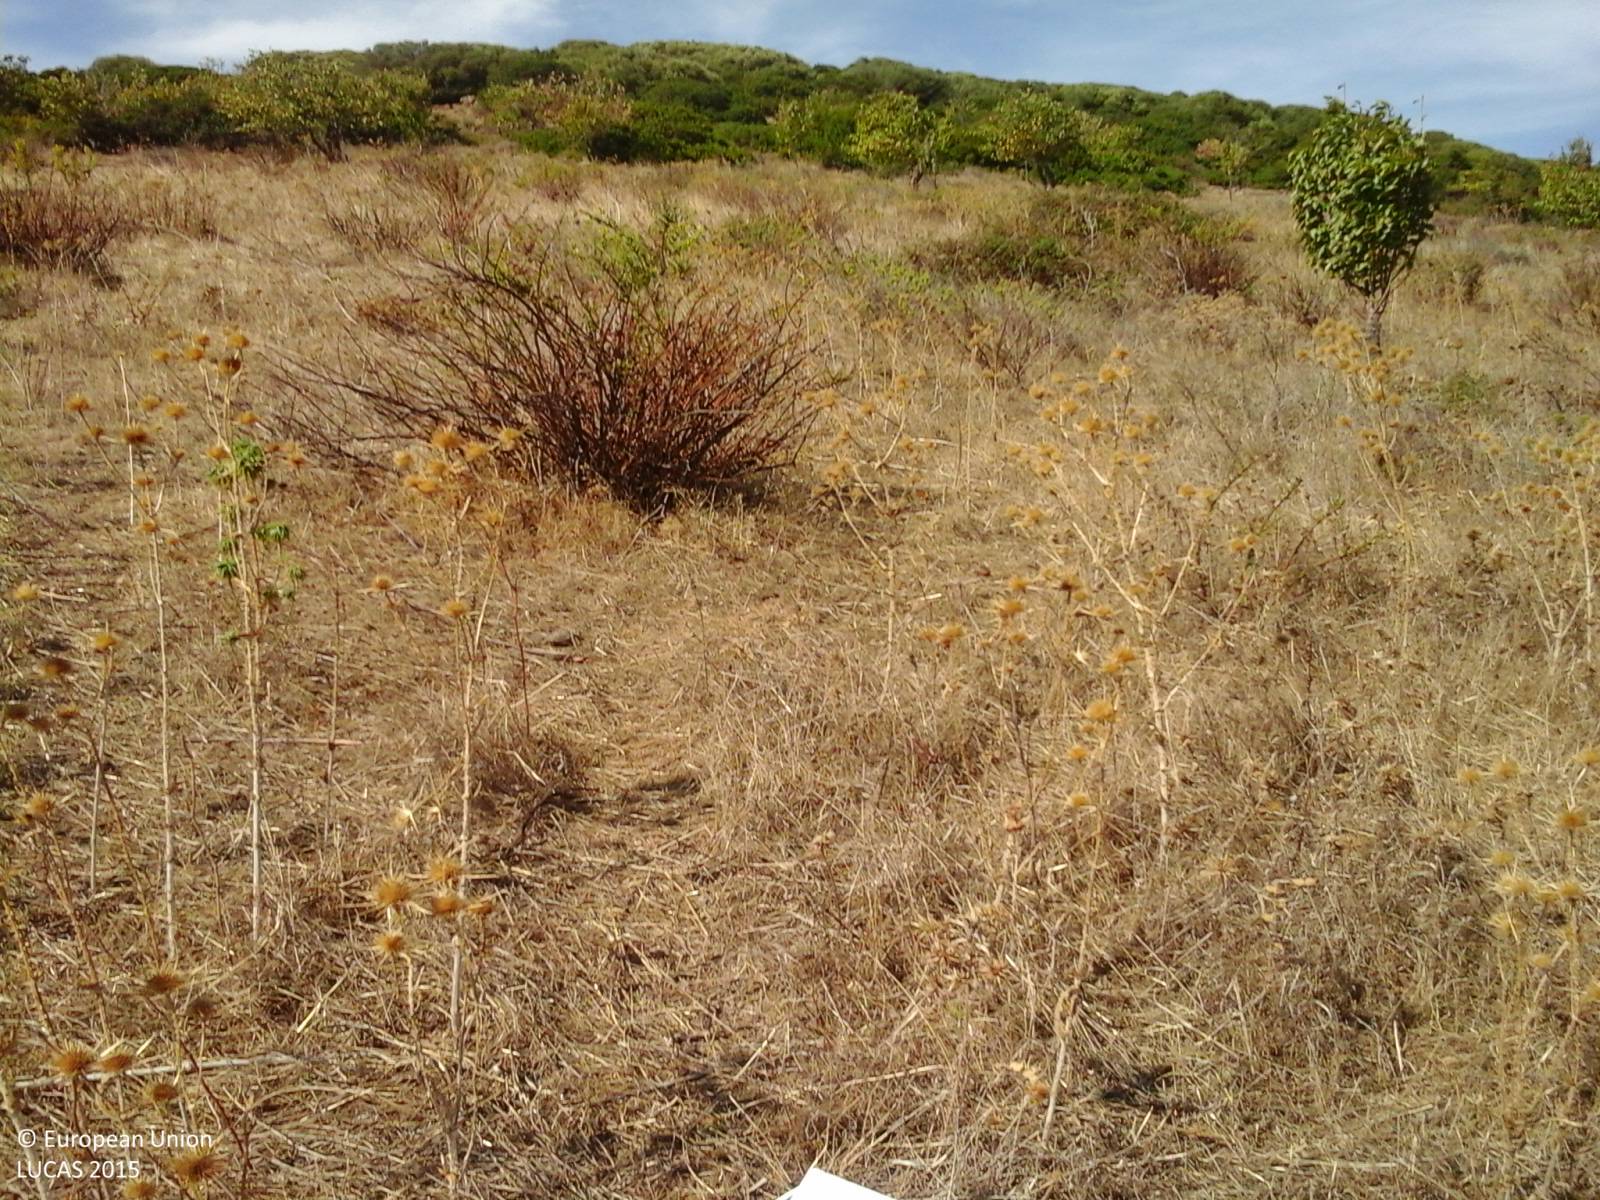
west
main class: Grassland
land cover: Grassland with sparse tree/shrub cover
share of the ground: > 75 %
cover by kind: herbaceous plants 90 %, broadleaved forest trees 5 %, shrubs 5 %
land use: Agriculture (excluding fallow land and kitchen gardens)
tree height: < 5 m
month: September
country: IT
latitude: 40.0392
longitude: 8.5429
